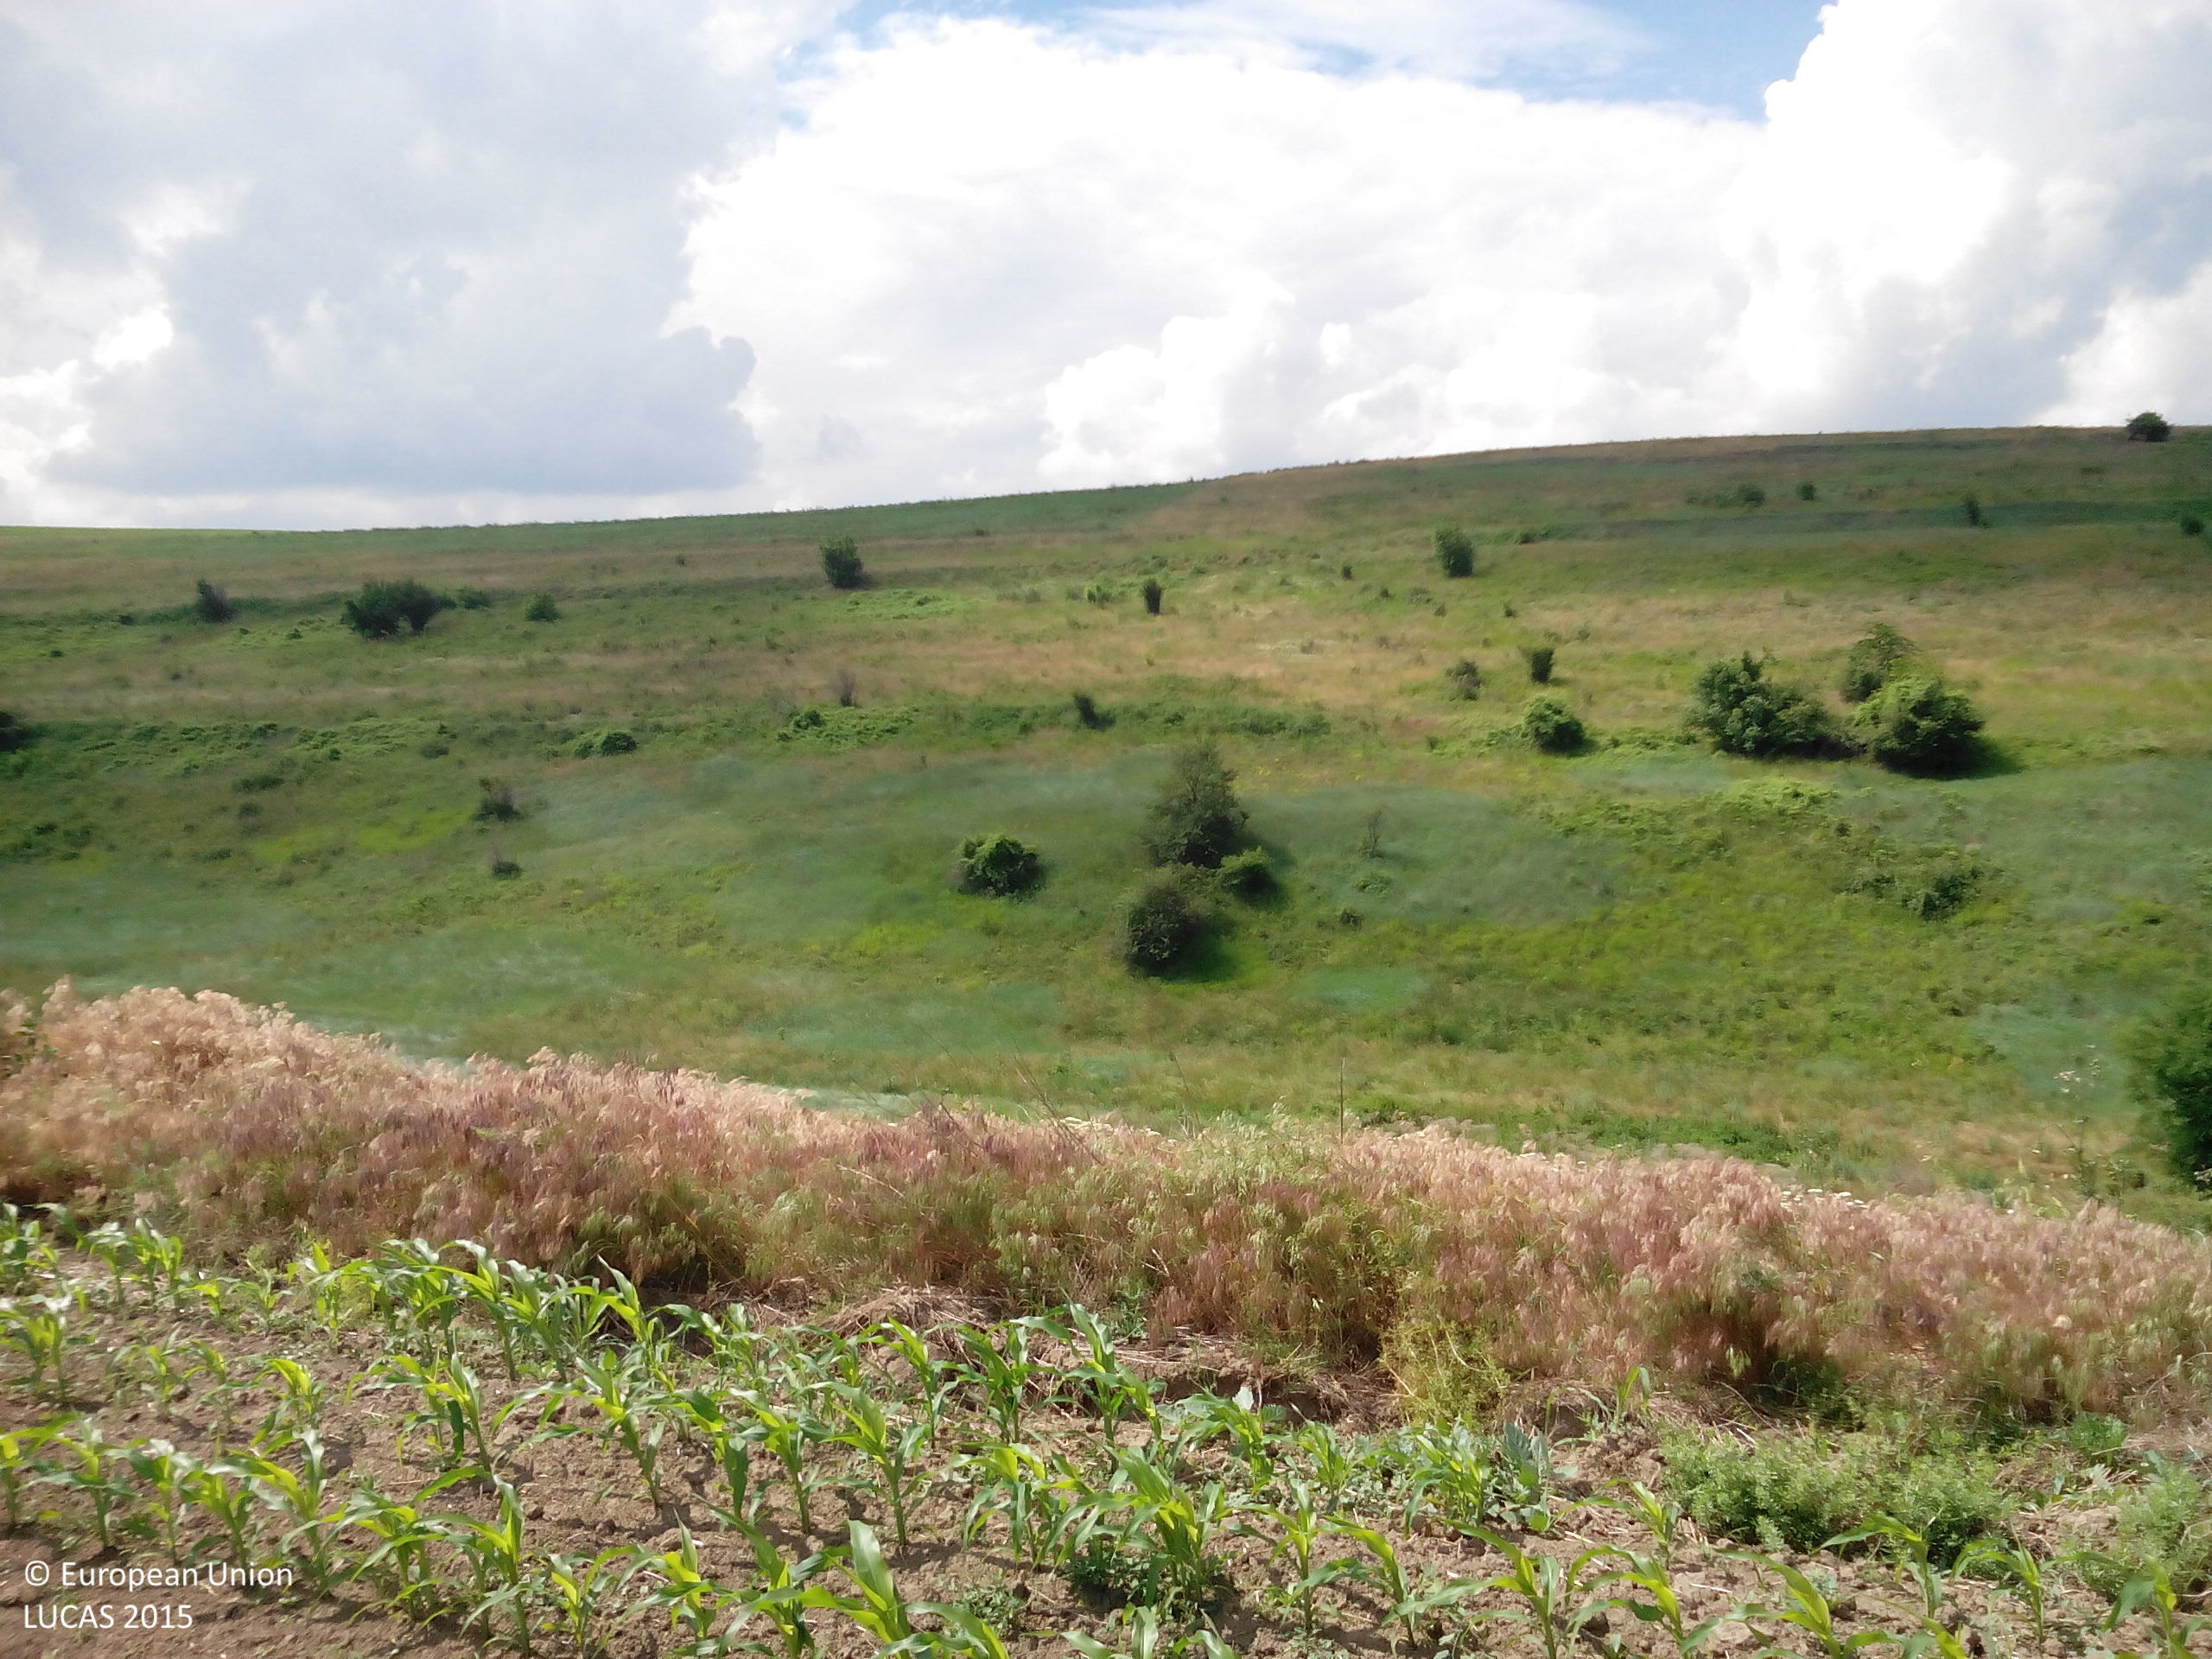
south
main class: Cropland
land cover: Maize
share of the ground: 25 - 50 %
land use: Agriculture (excluding fallow land and kitchen gardens)
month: May
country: BG
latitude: 43.6851
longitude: 24.2886
